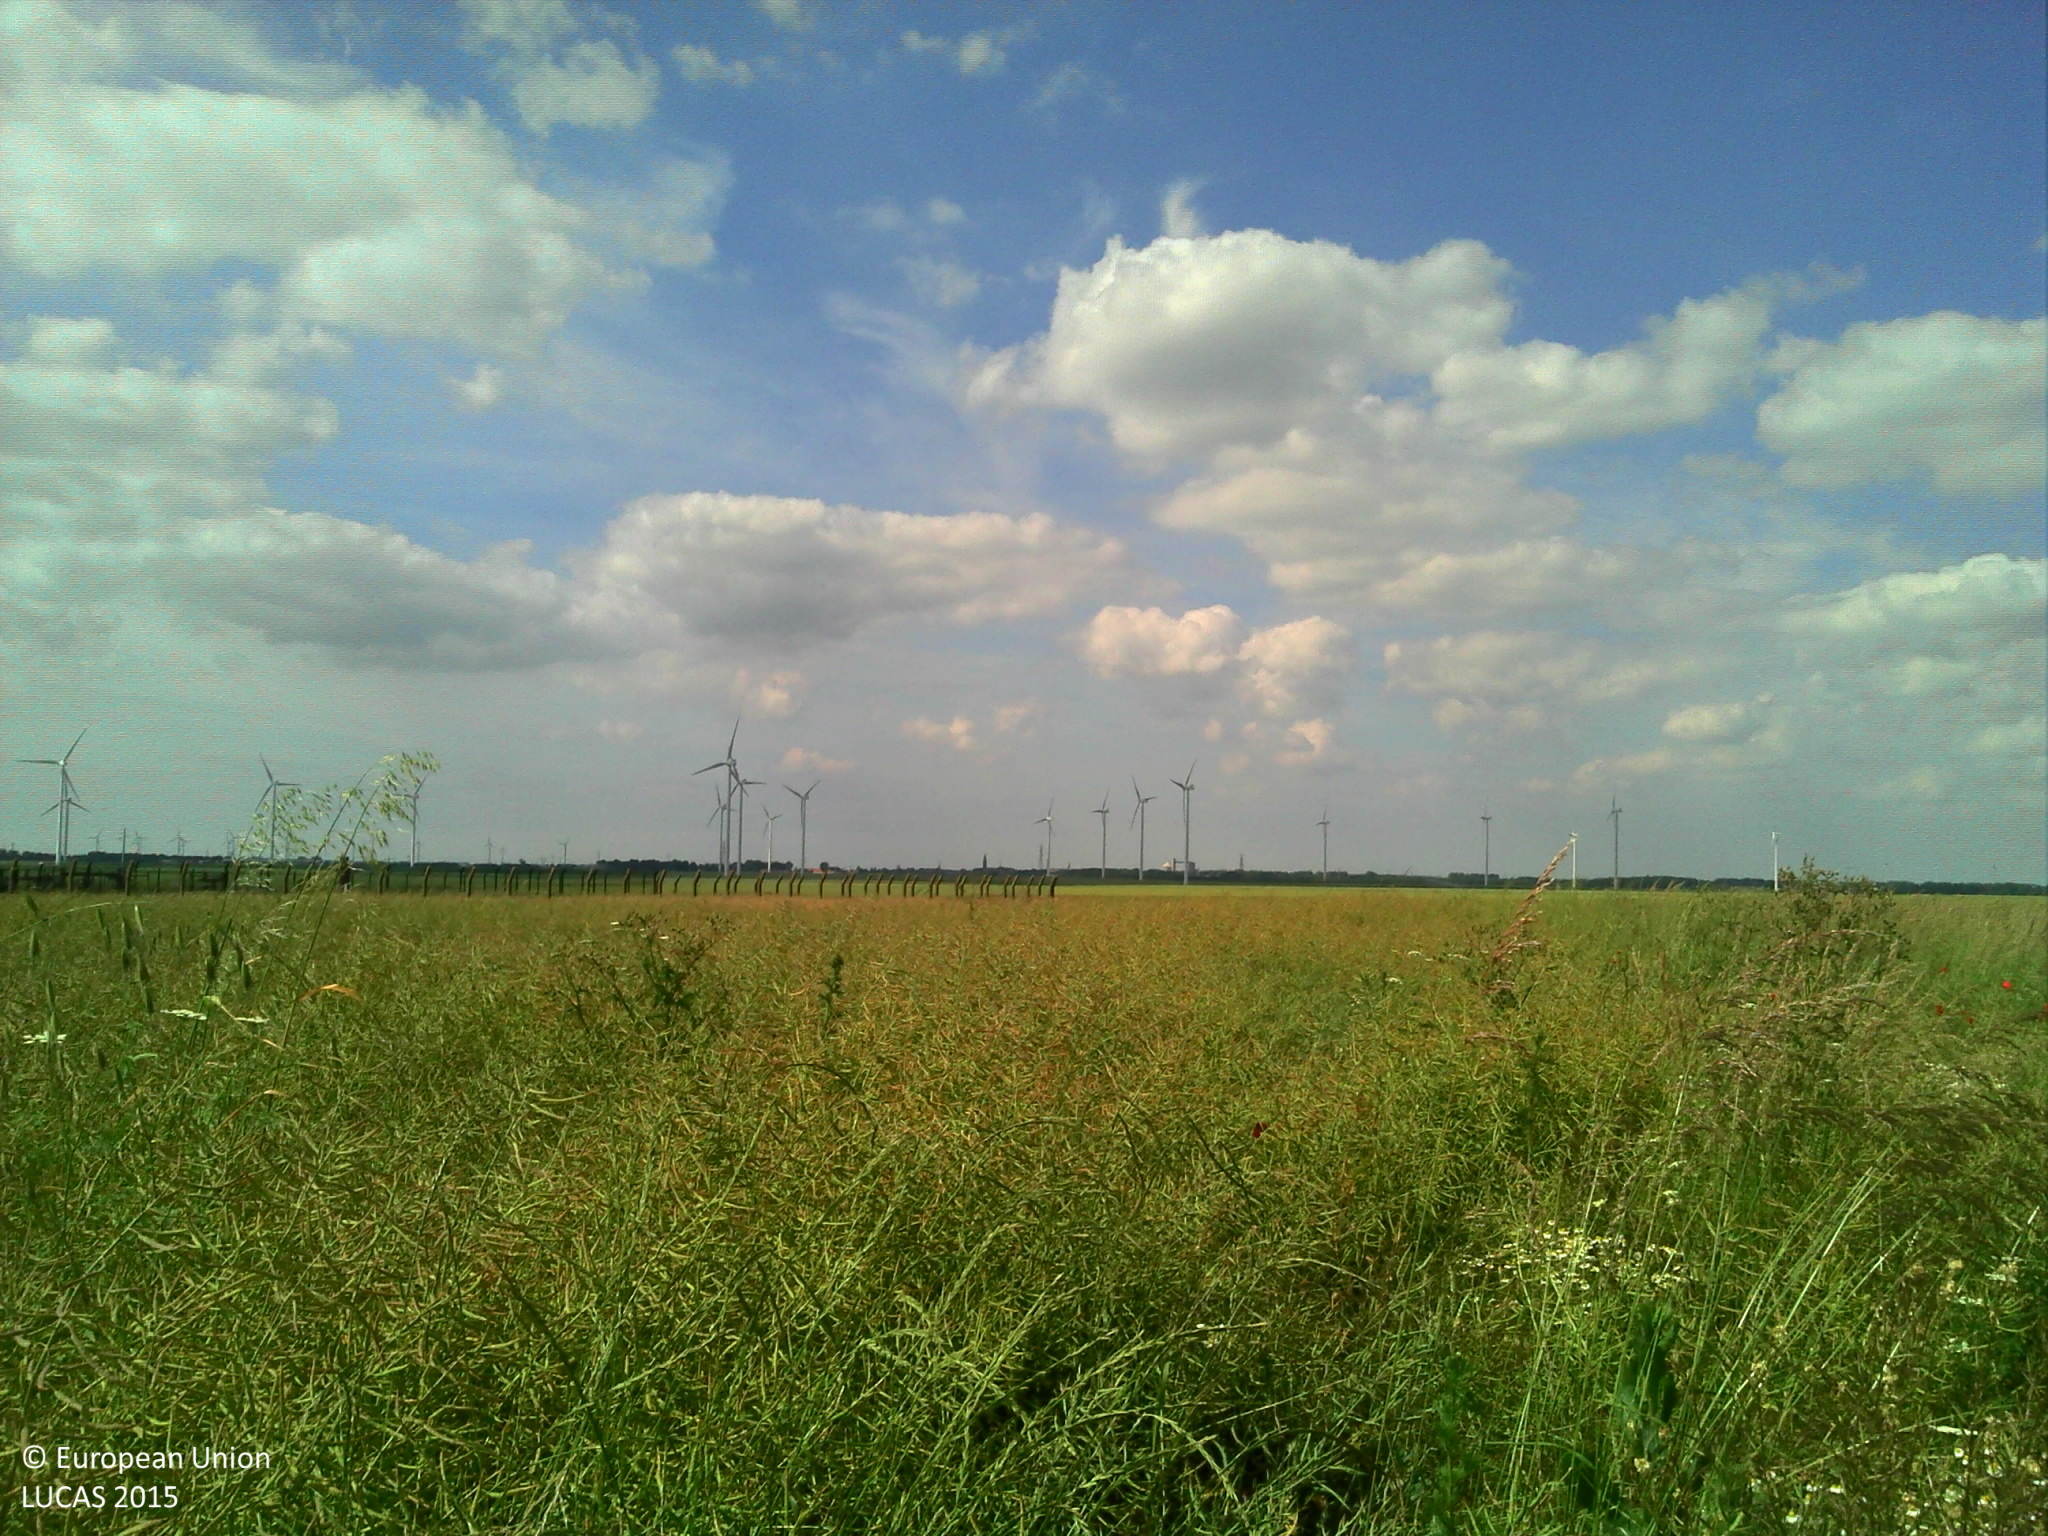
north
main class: Cropland
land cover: Rape and turnip rape
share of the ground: > 75 %
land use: Agriculture (excluding fallow land and kitchen gardens)
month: June
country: FR
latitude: 49.6496
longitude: 2.8011
